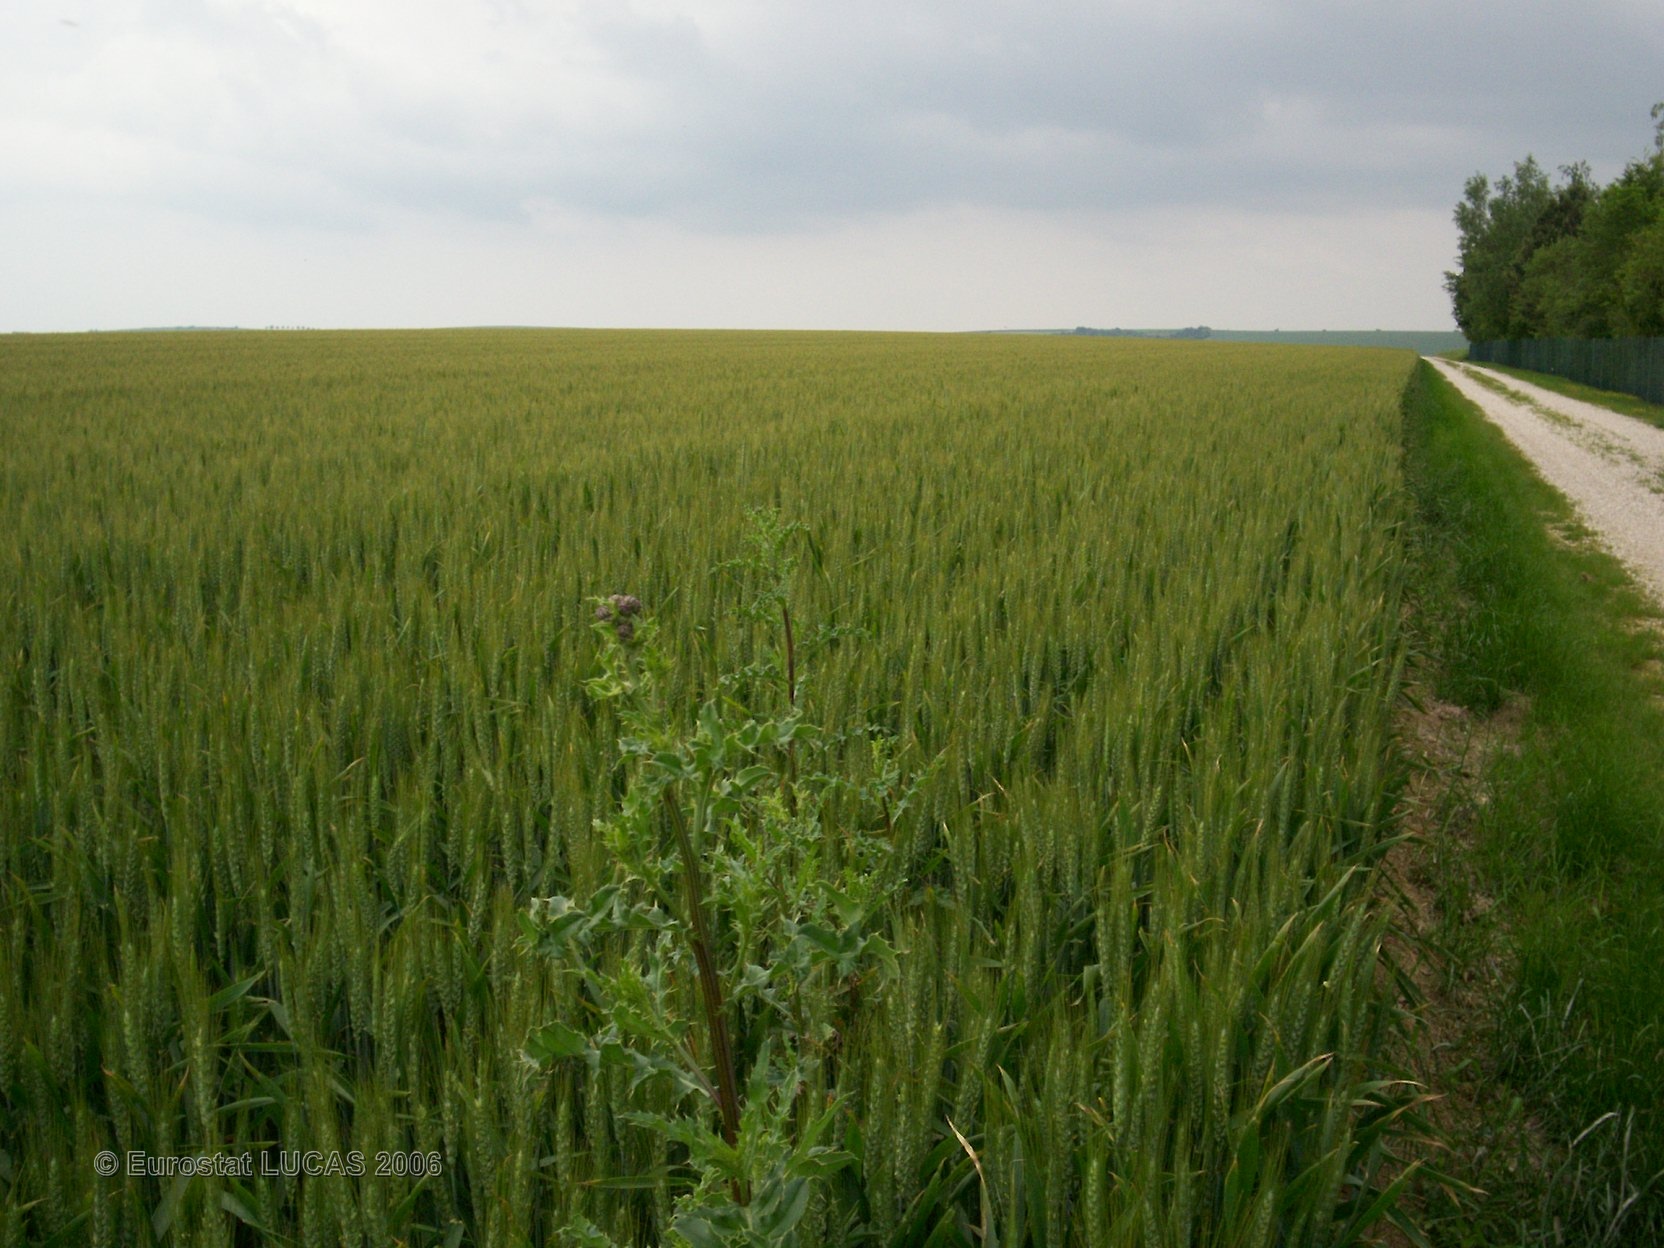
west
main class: Cropland
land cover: Barley
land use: Agriculture (excluding fallow land and kitchen gardens)
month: June
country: FR
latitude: 48.6992
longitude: 4.4942
